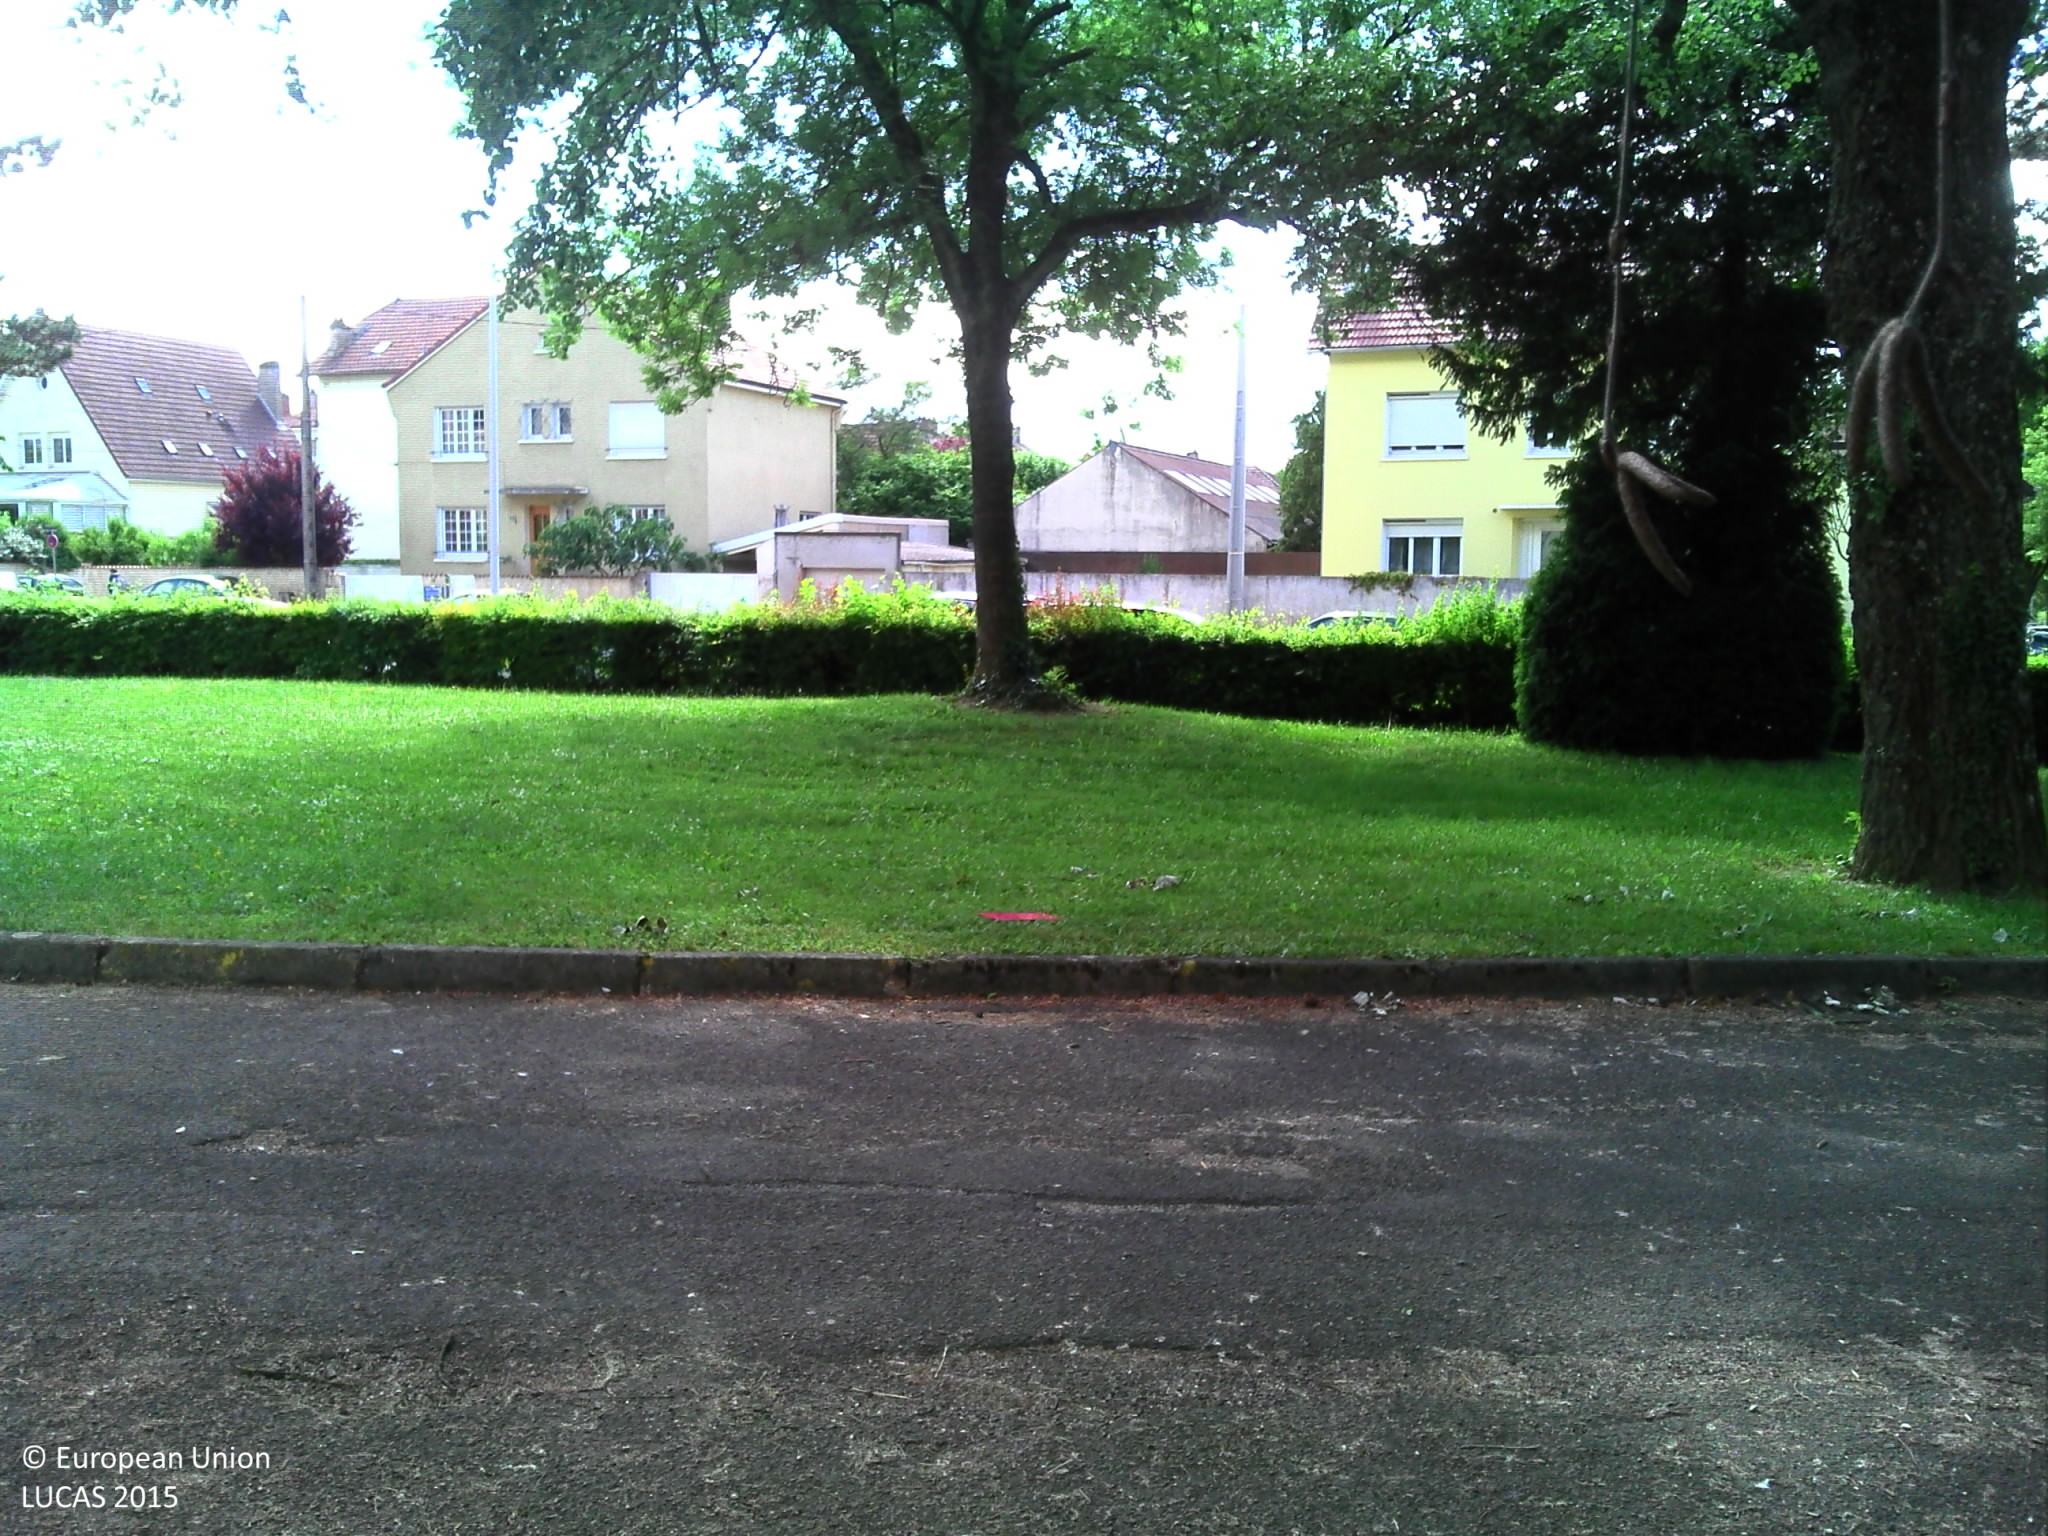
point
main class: Woodland
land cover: Pine dominated mixed woodland
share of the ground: > 75 %
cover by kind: herbaceous plants 65 %, coniferous forest trees 20 %, broadleaved forest trees 15 %
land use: Community services
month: June
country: FR
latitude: 47.3197
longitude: 5.0657
